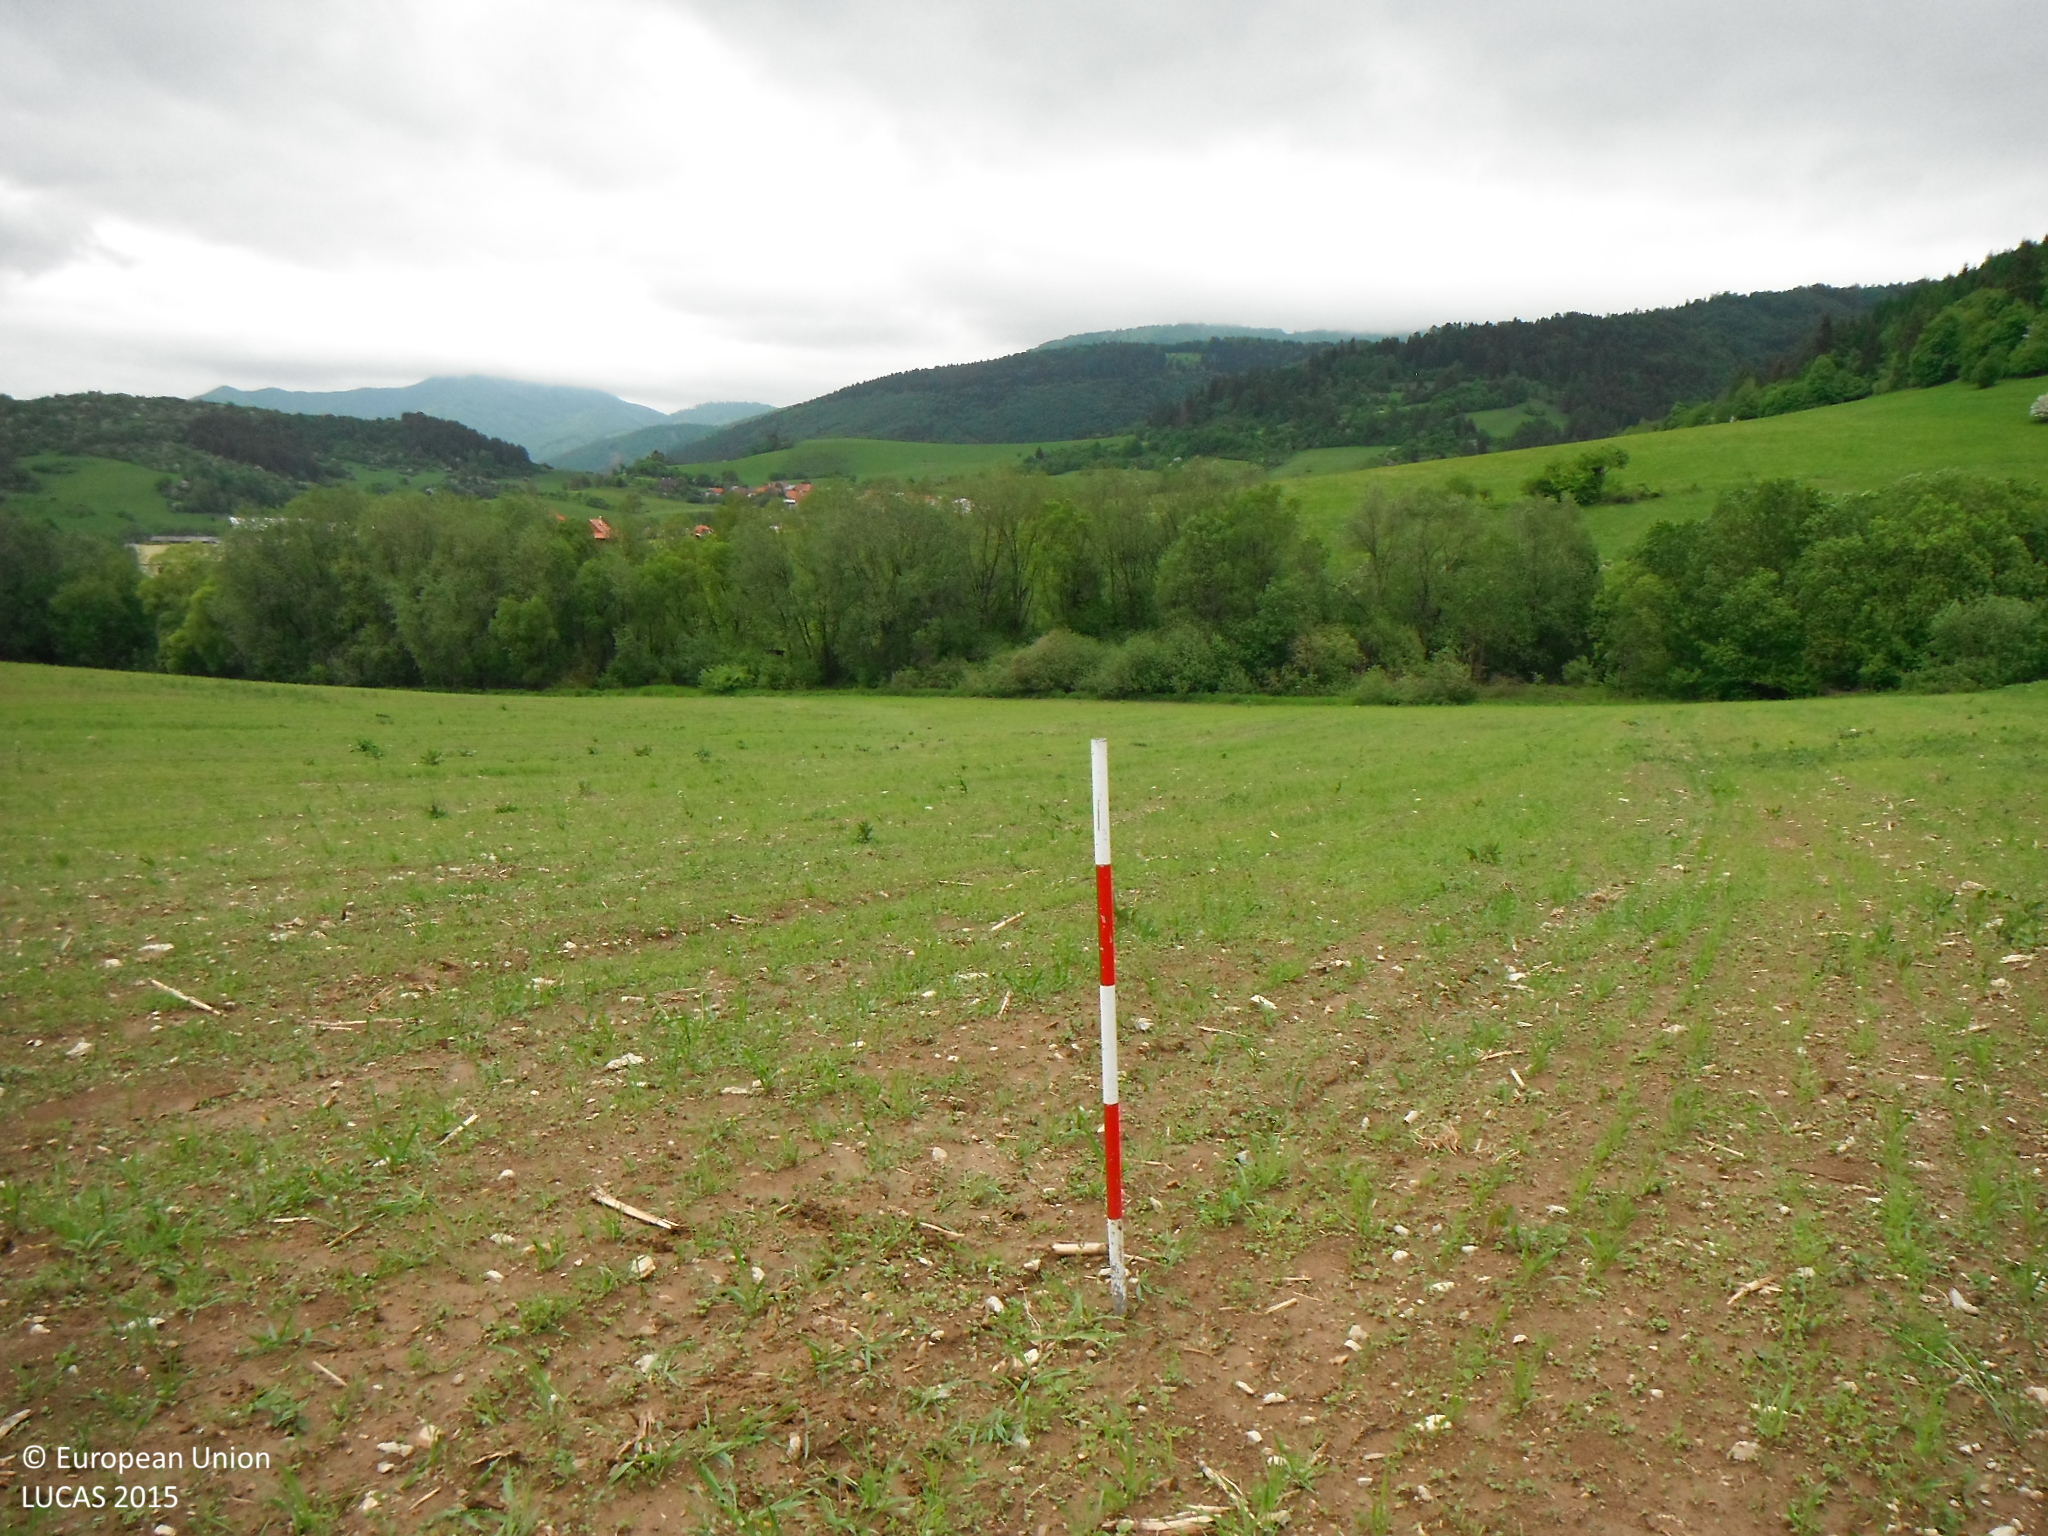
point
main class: Cropland
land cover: Common wheat
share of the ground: 25 - 50 %
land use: Agriculture (excluding fallow land and kitchen gardens)
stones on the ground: 10 - 25 %
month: May
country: SK
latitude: 49.0821
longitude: 19.0448
